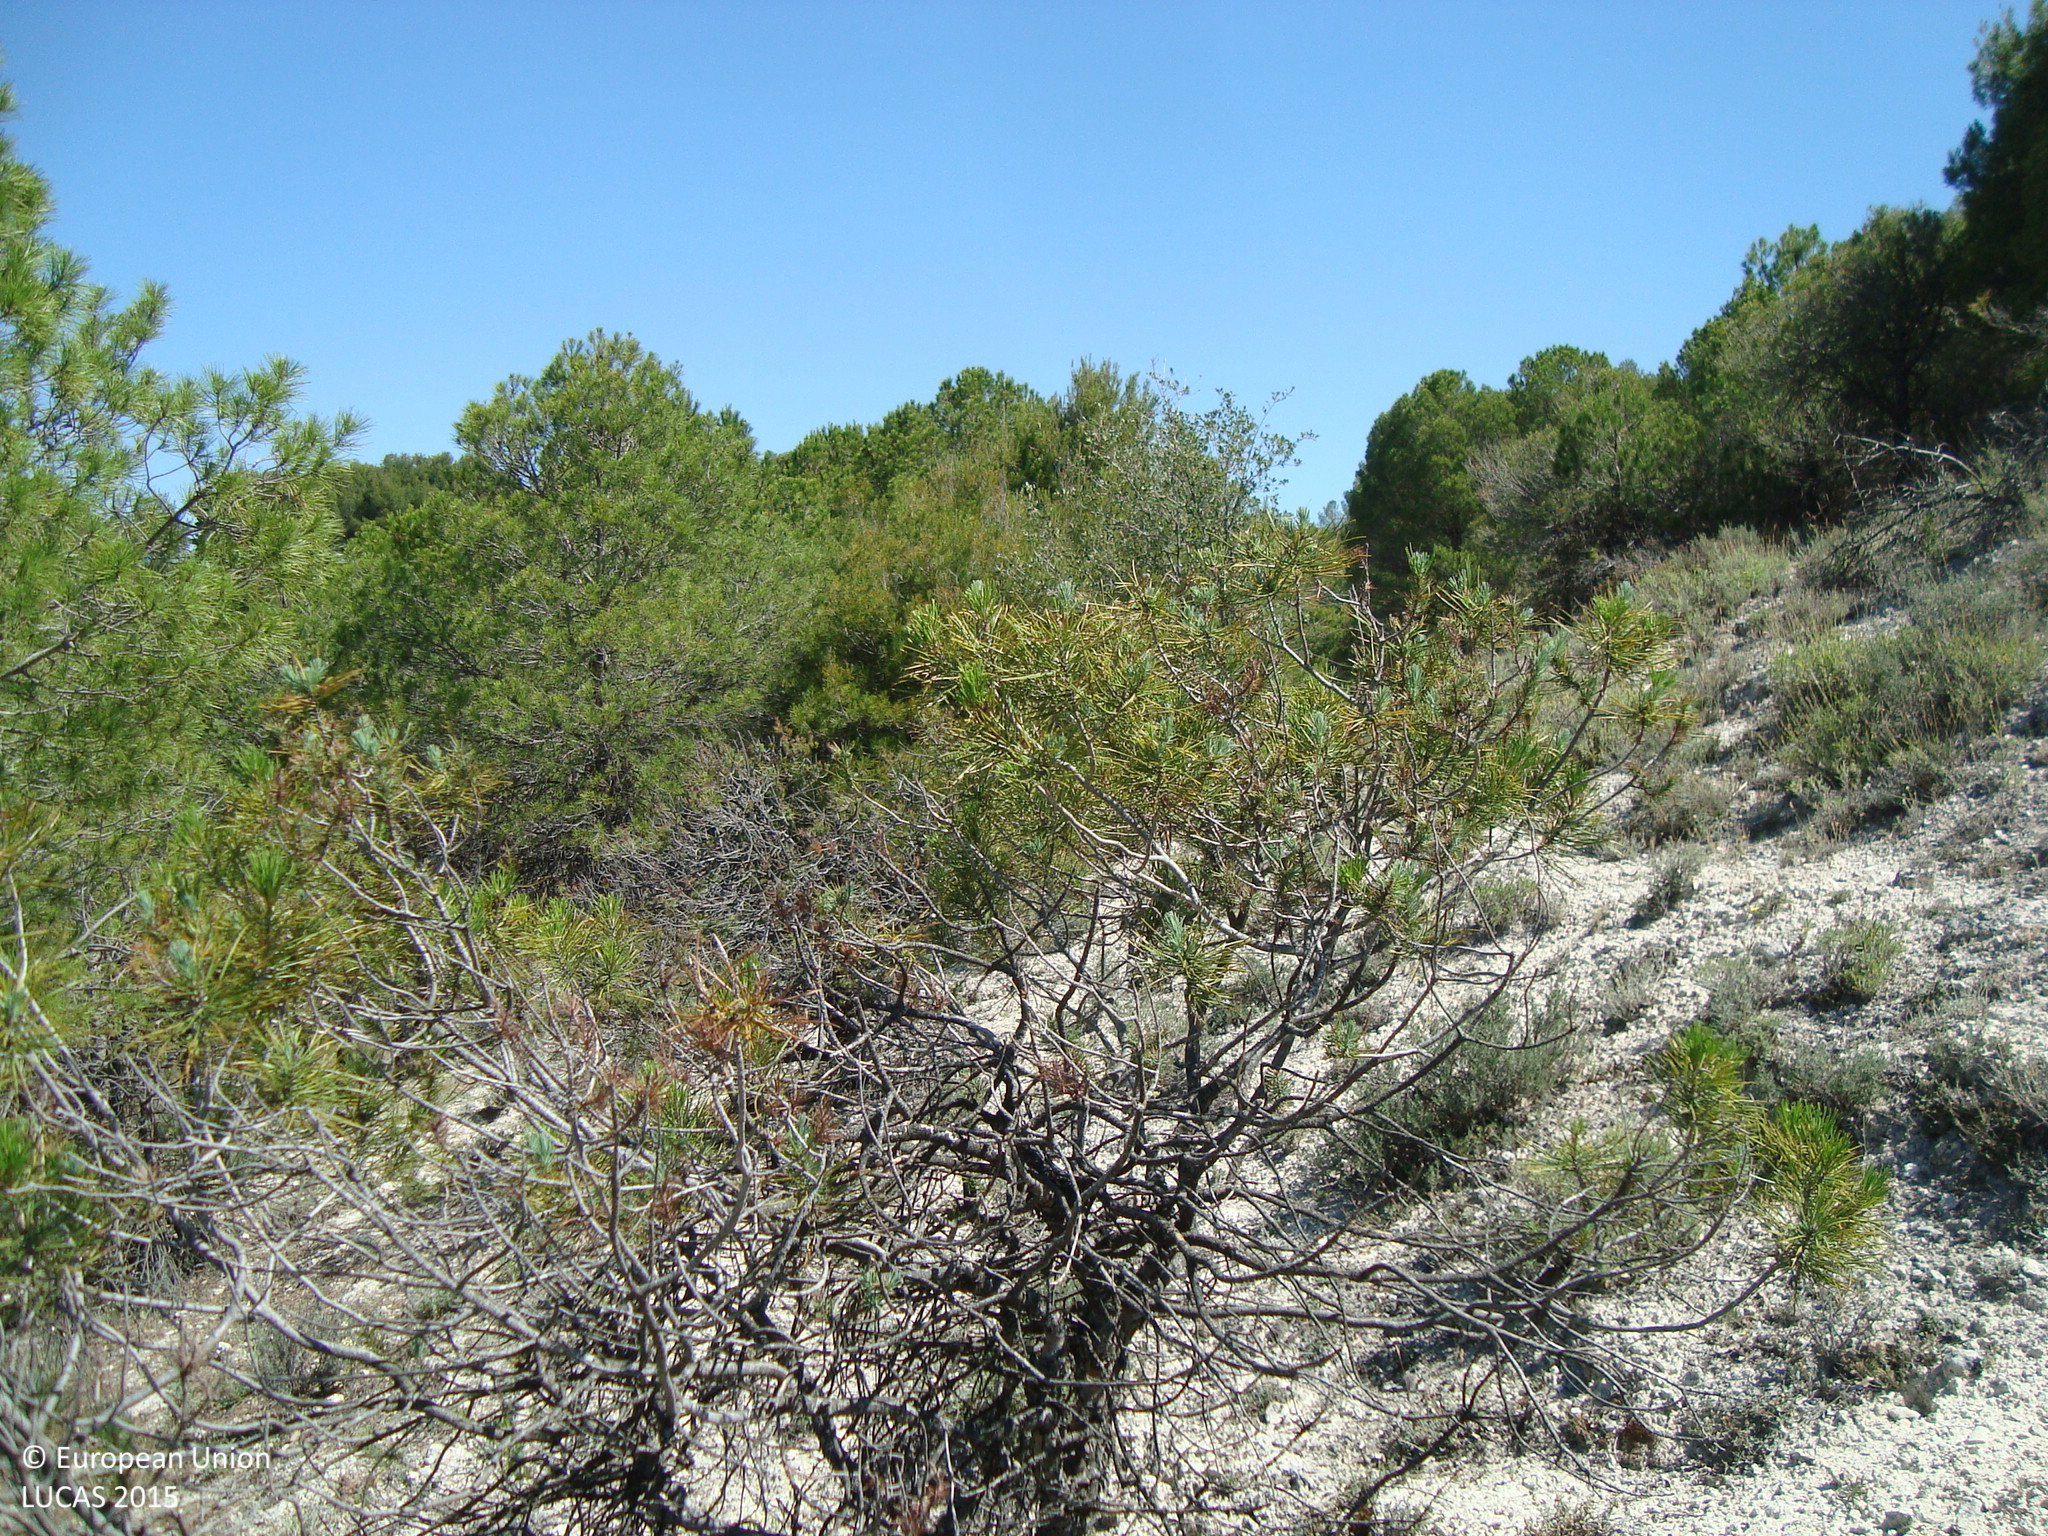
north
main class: Woodland
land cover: Pine dominated mixed woodland
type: coniferous forest of the mediterranean region
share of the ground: 50 - 75 %
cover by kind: coniferous forest trees 40 %, unconsolidated bare surface 25 %, shrubs 20 %, broadleaved forest trees 15 %
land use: Forestry
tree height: > 5 m
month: June
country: ES
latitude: 41.3854
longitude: -4.6173
